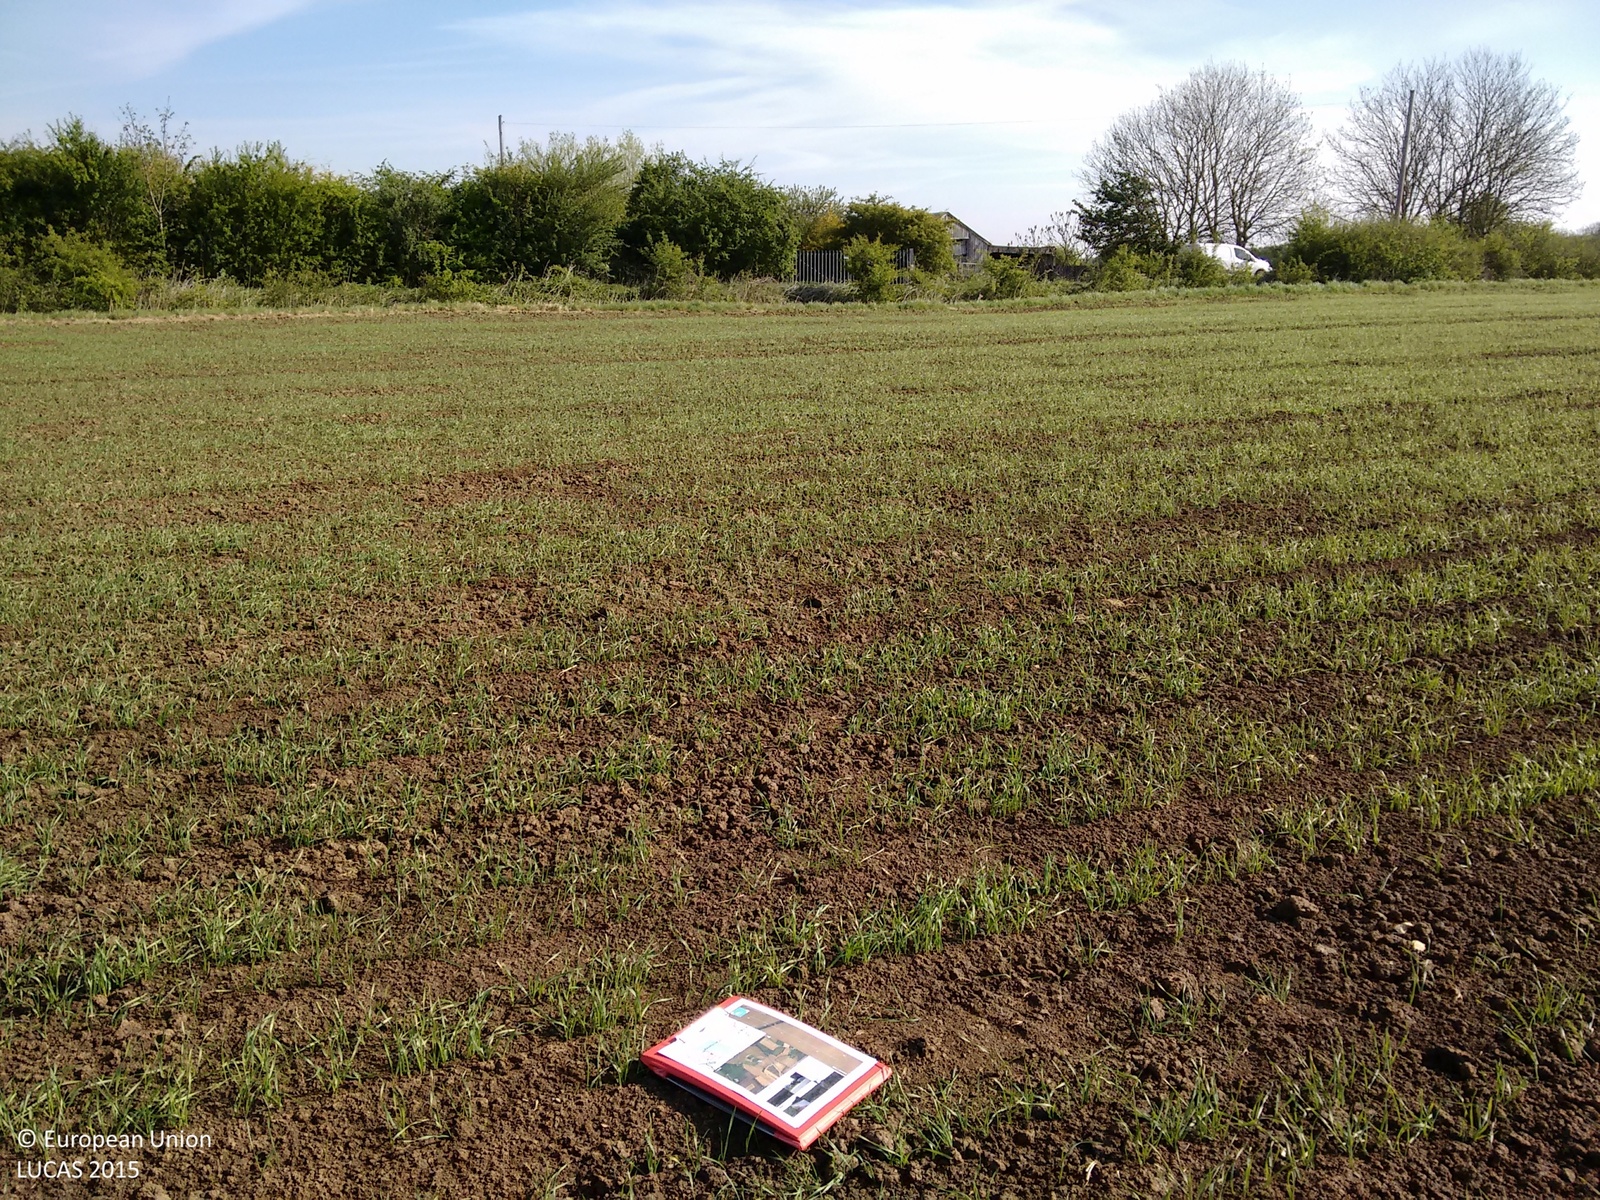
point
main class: Cropland
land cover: Common wheat
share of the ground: < 10 %
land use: Agriculture (excluding fallow land and kitchen gardens)
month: May
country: GB
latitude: 53.2807
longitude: 0.2670
